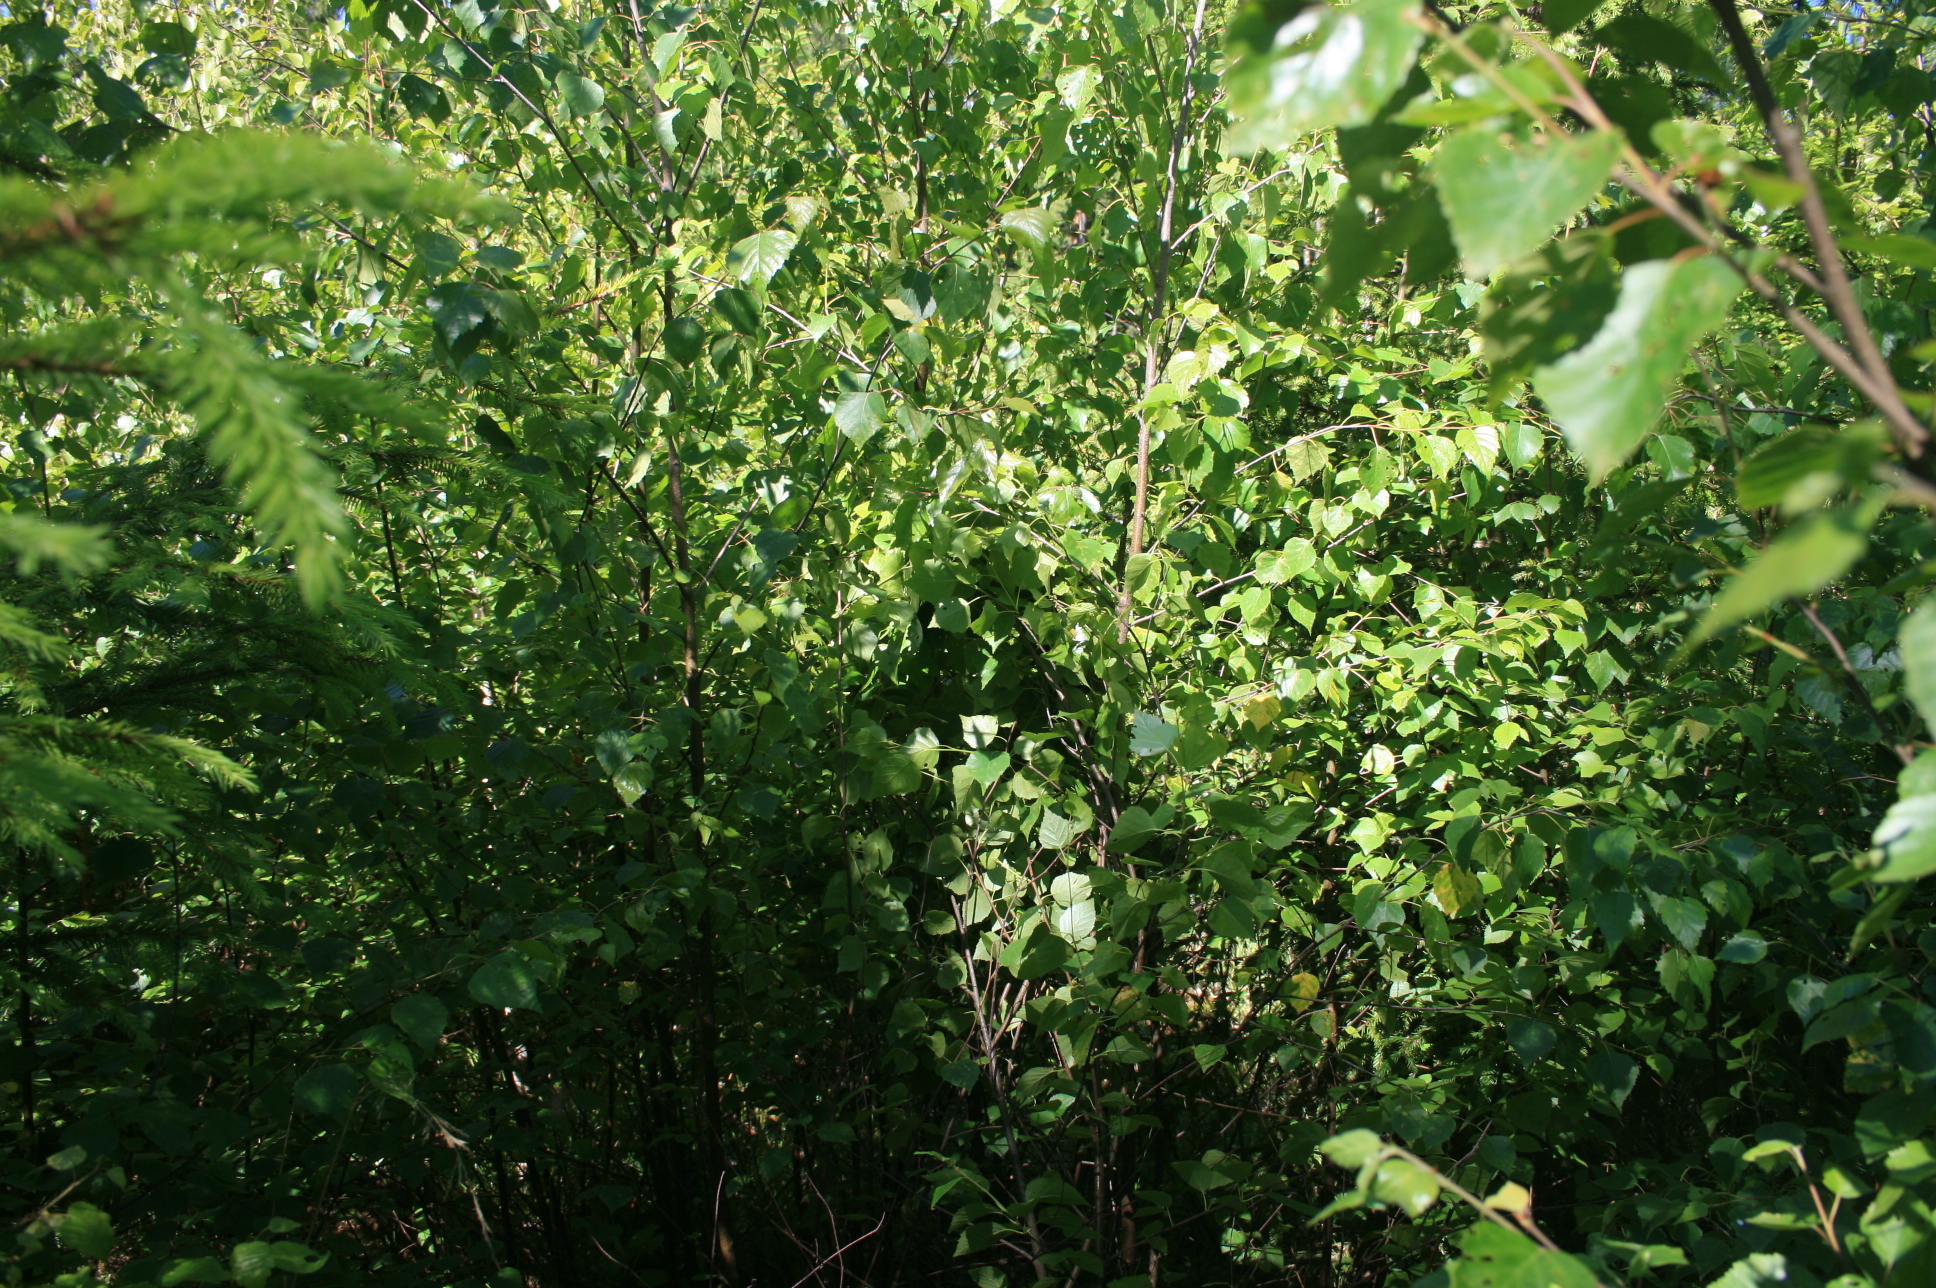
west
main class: Woodland
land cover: Spruce dominated mixed woodland
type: hemiboreal forest and nemoral coniferous forest and mixed broadleaved-coniferous forest
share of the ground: > 75 %
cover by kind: broadleaved forest trees 55 %, coniferous forest trees 45 %
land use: Forestry
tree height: < 5 m
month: June
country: LT
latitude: 55.4441
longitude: 22.1489
